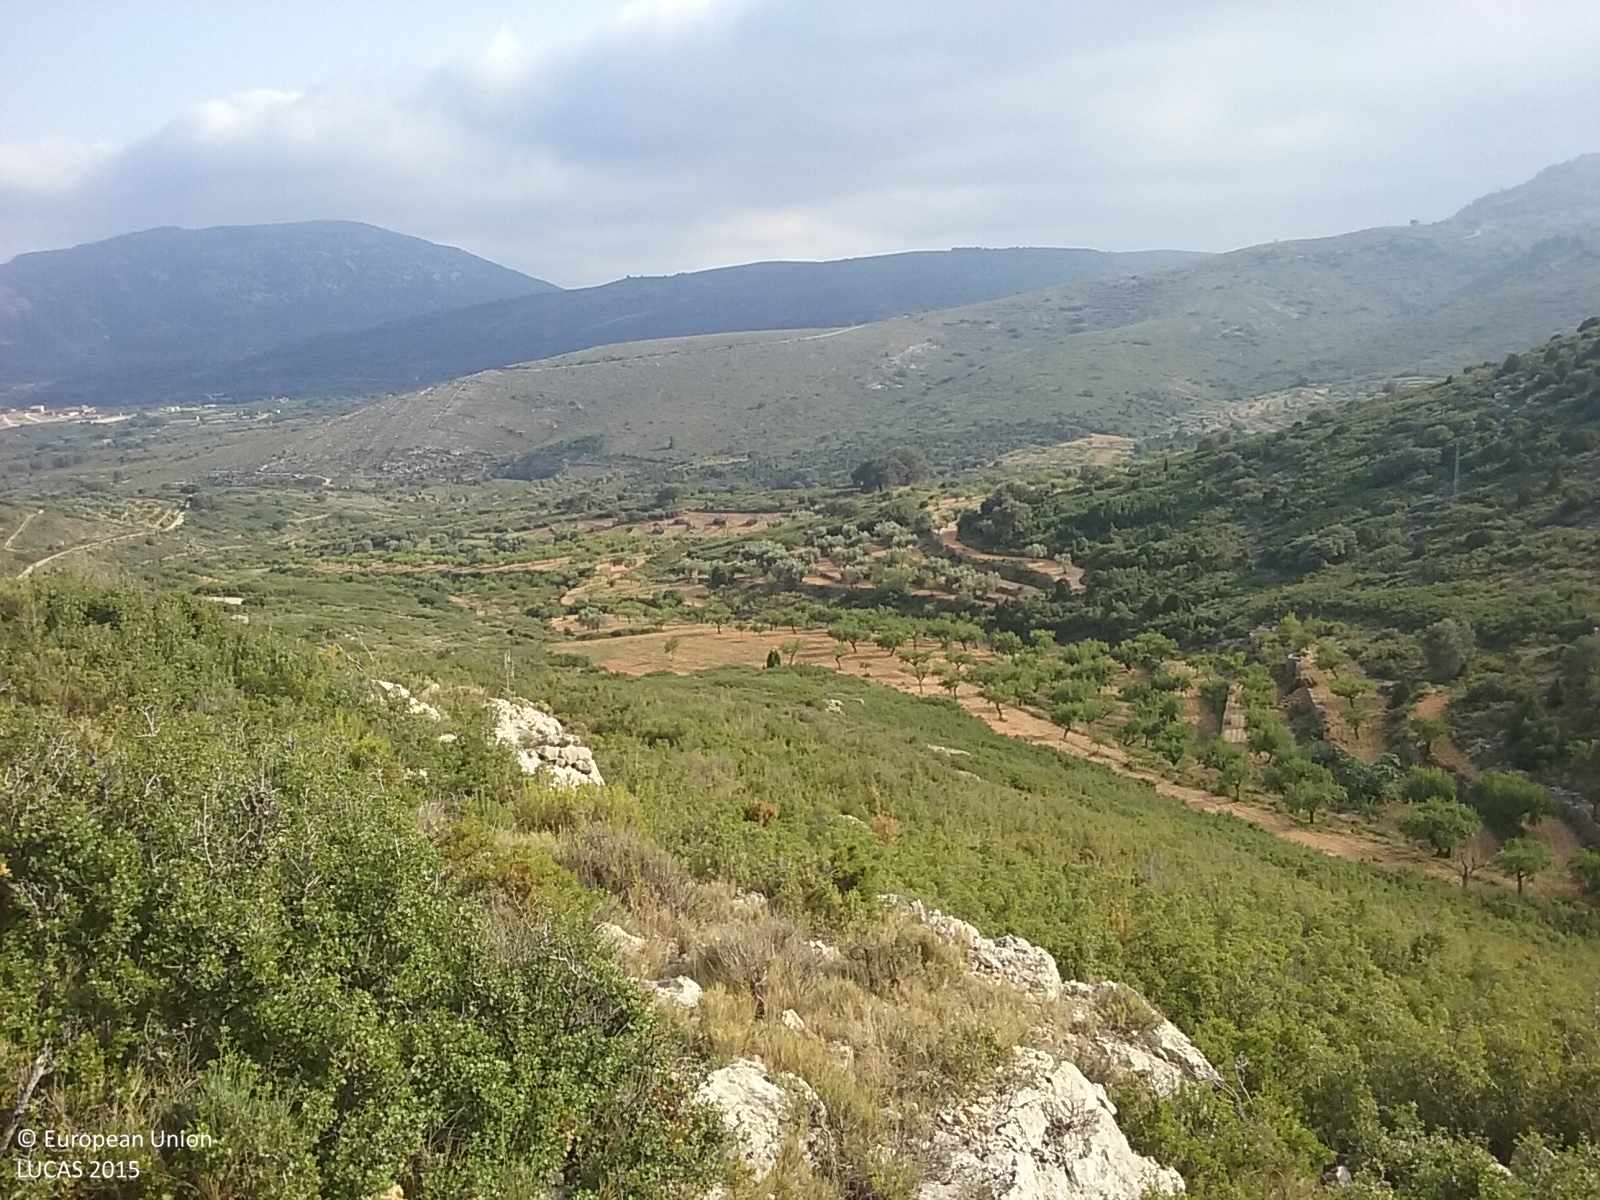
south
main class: Shrubland
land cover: Shrubland with sparse tree cover
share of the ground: > 75 %
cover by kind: shrubs 95 %, coniferous forest trees 5 %
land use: Semi-natural and natural areas not in use
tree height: < 5 m
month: August
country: ES
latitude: 40.3466
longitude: -0.0942
